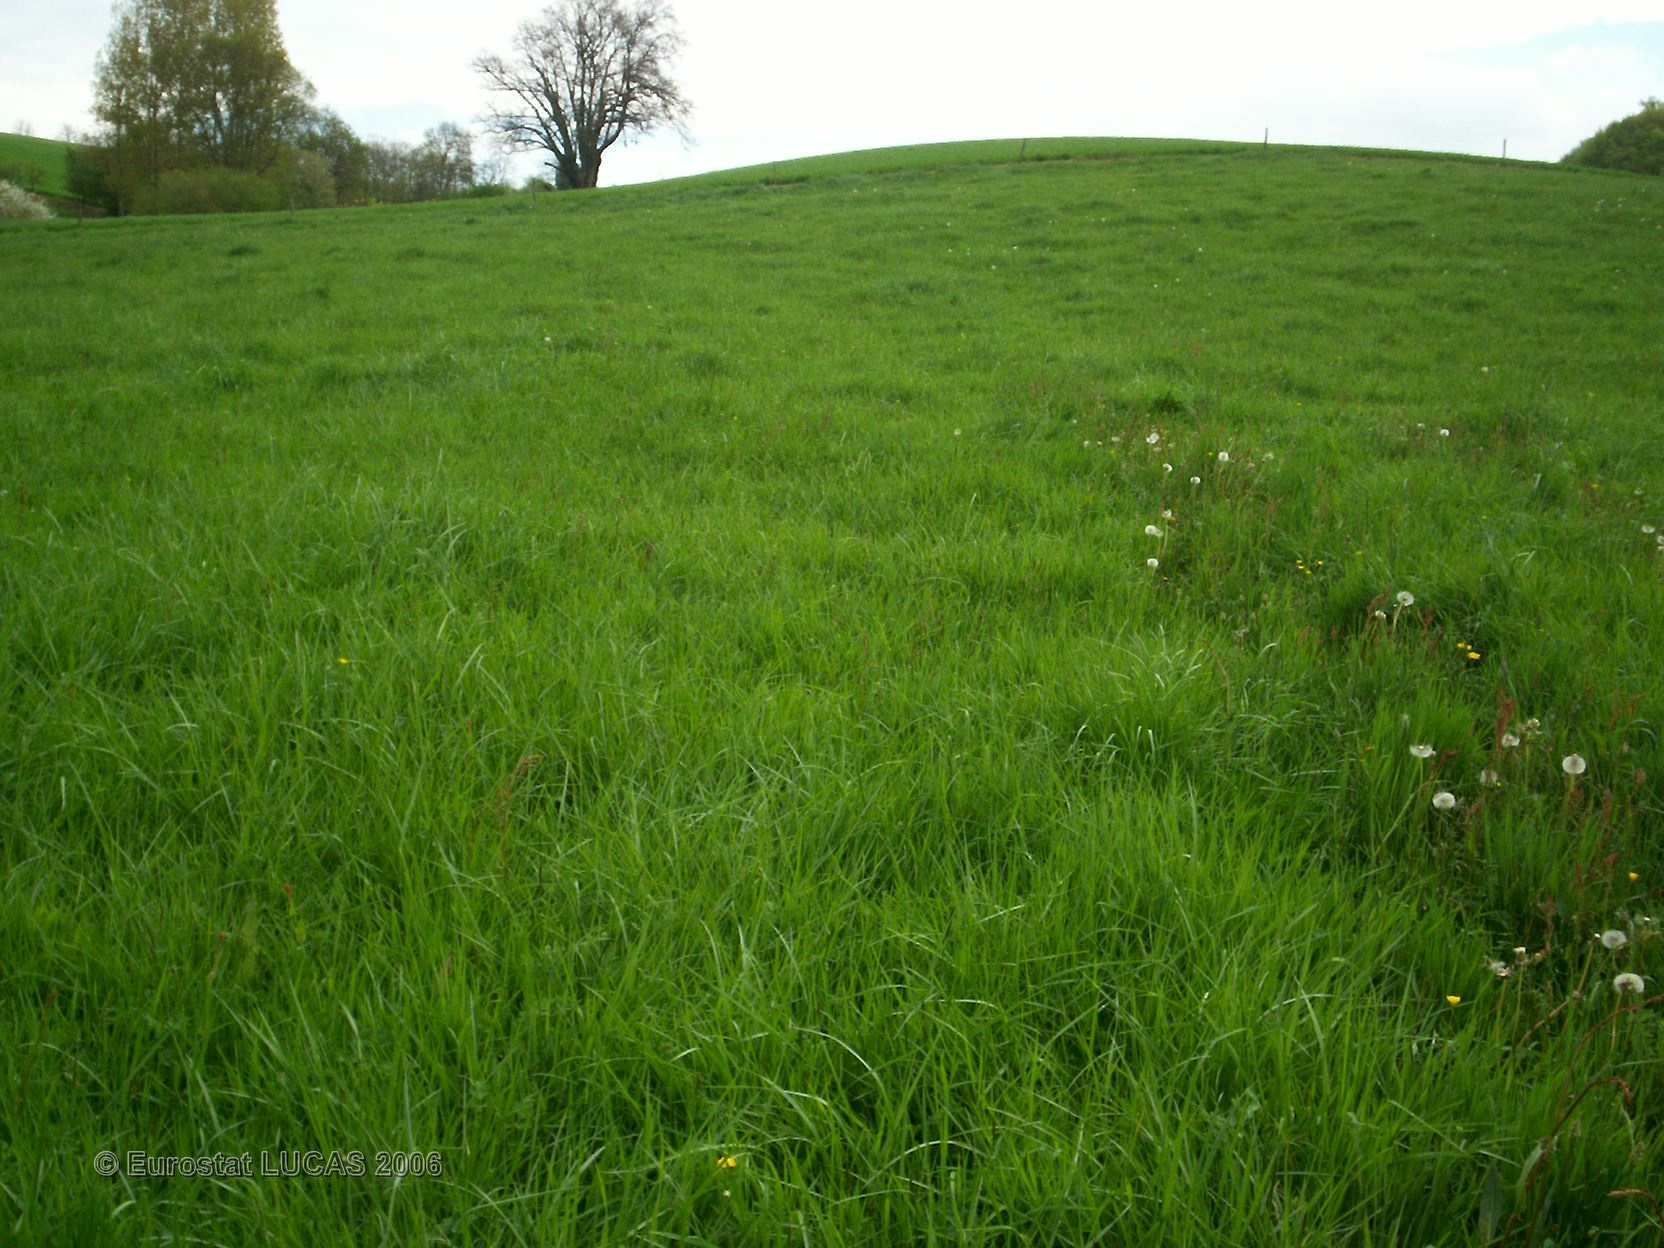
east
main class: Grassland
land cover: Grassland without tree/shrub cover
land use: Agriculture (excluding fallow land and kitchen gardens)
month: April
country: FR
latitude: 43.7223
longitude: 0.2007
